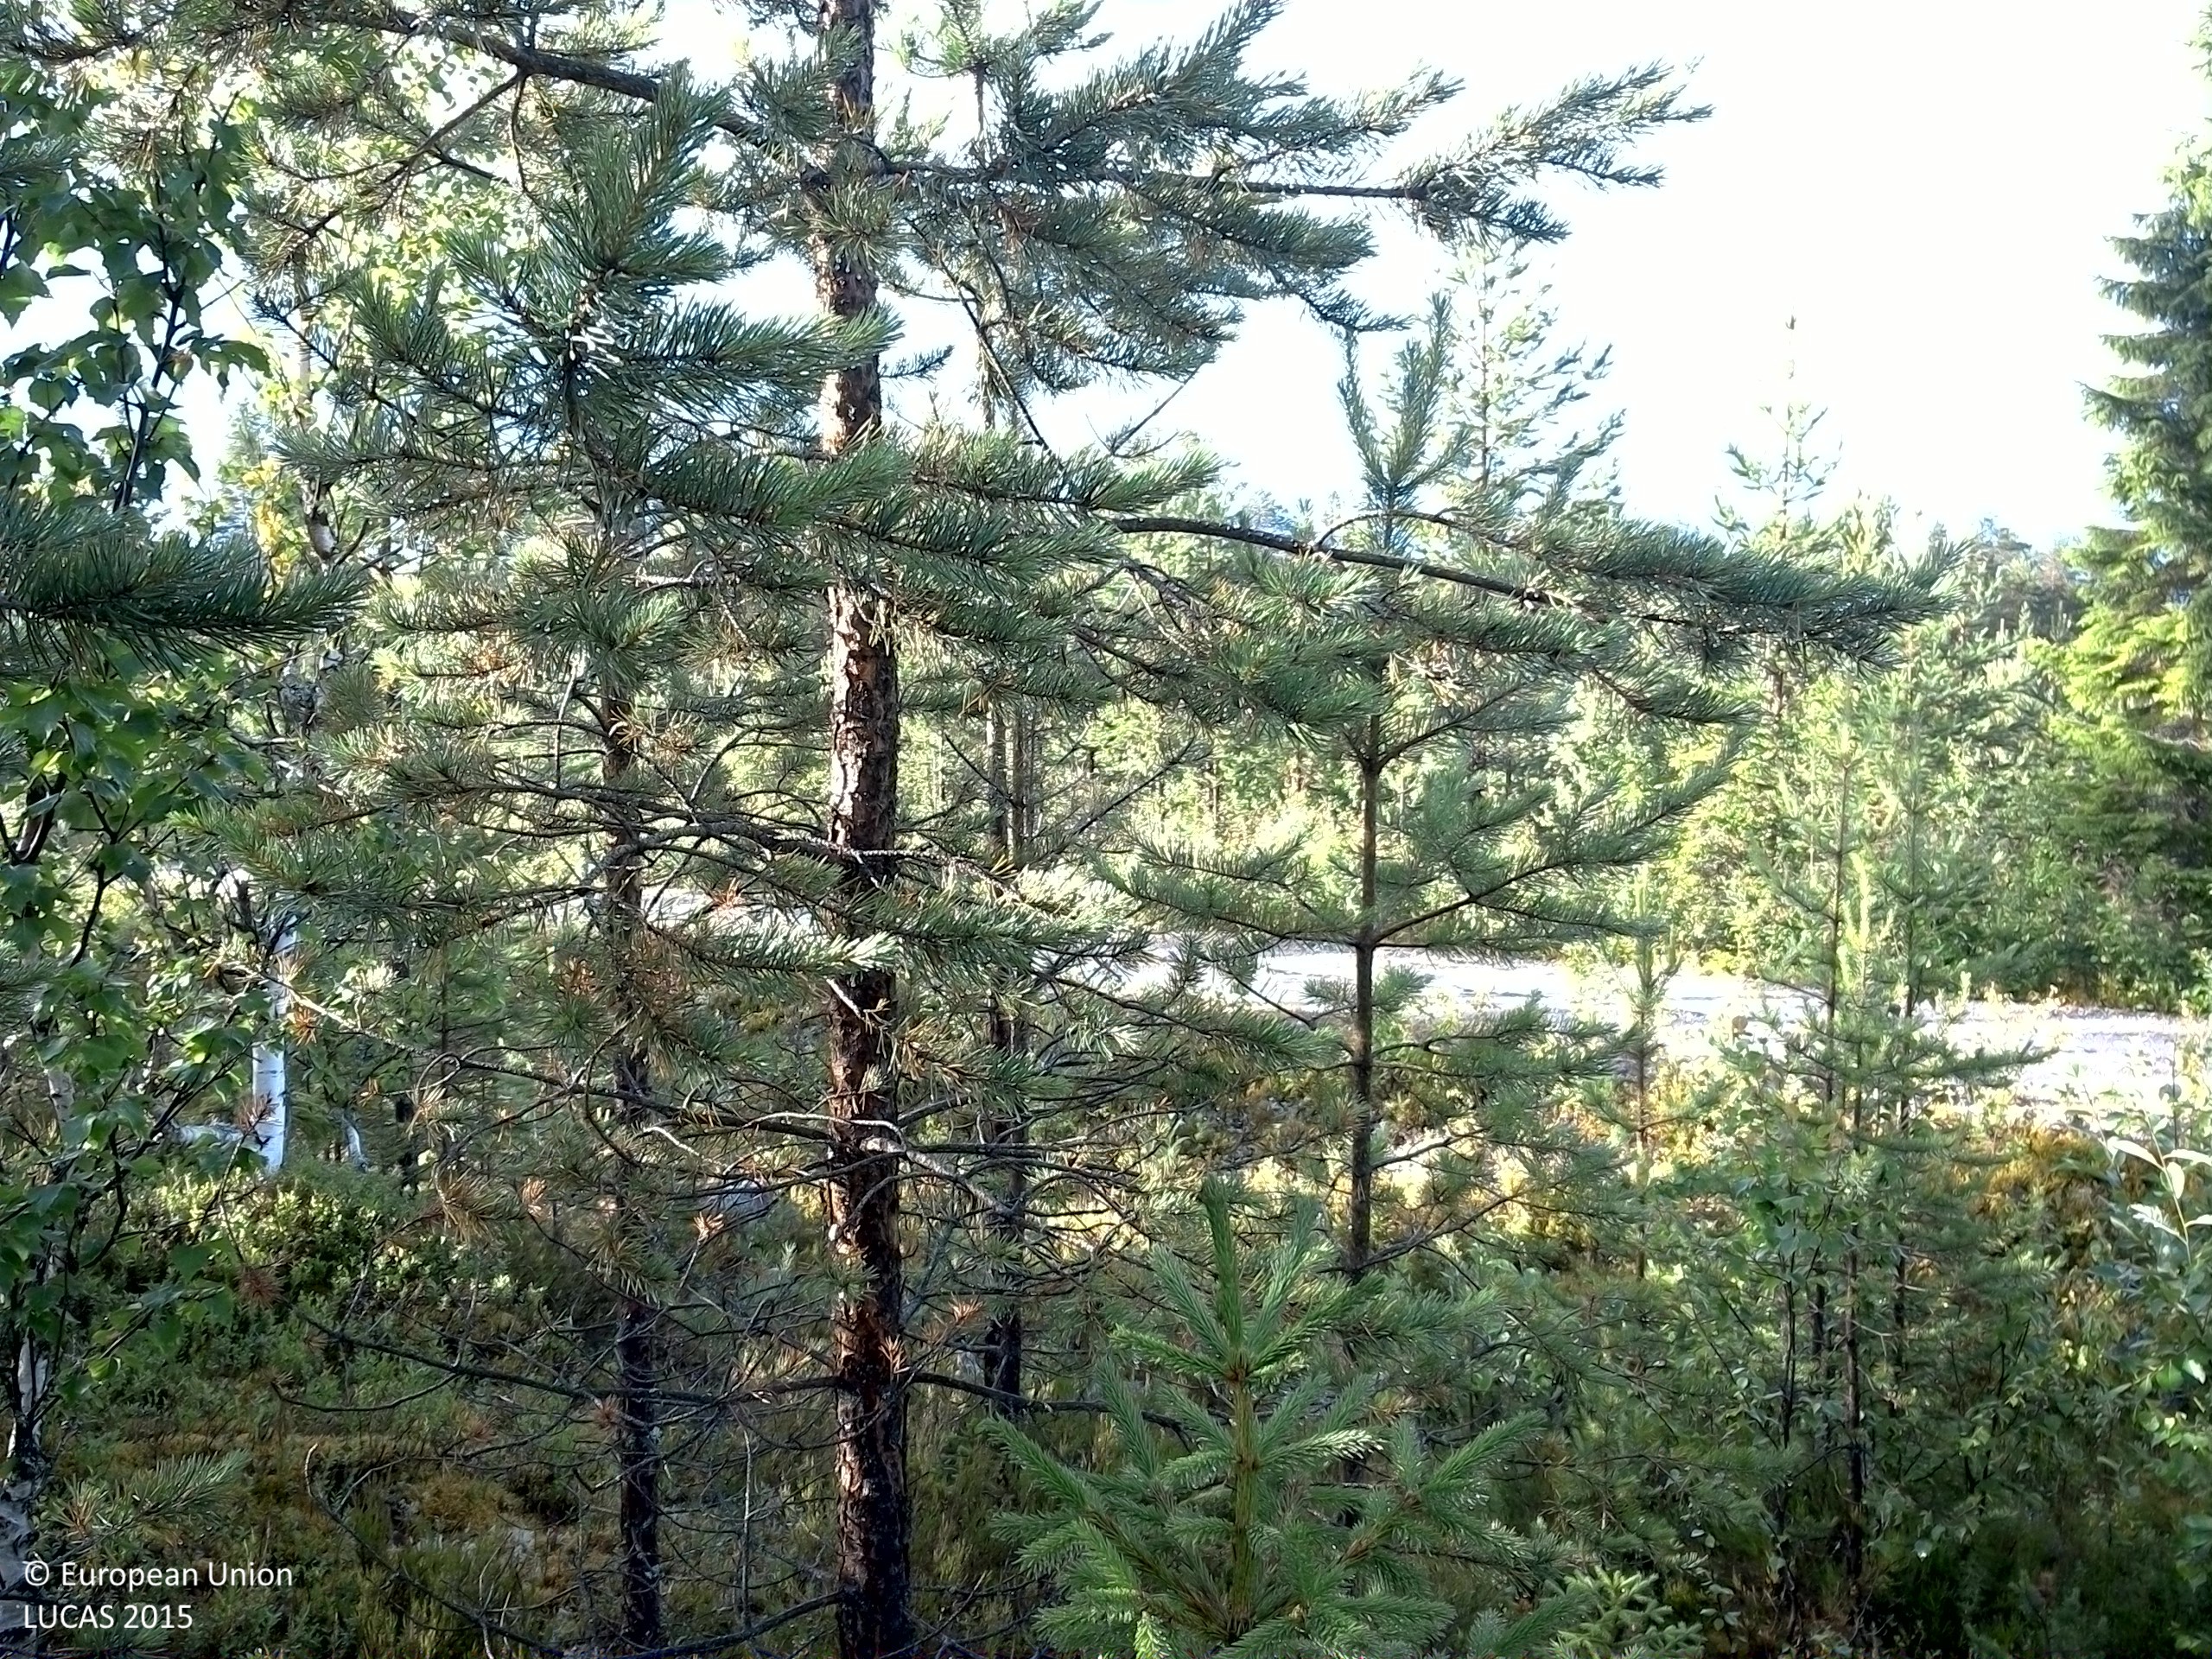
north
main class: Woodland
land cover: Pine dominated coniferous woodland
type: boreal forest
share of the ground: 25 - 50 %
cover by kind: coniferous forest trees 40 %, shrubs 35 %, lichens and mosses 15 %, broadleaved forest trees 5 %, consolidated bare surface 5 %
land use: Forestry
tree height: < 5 m
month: July
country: SE
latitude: 63.8022
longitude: 17.1386
